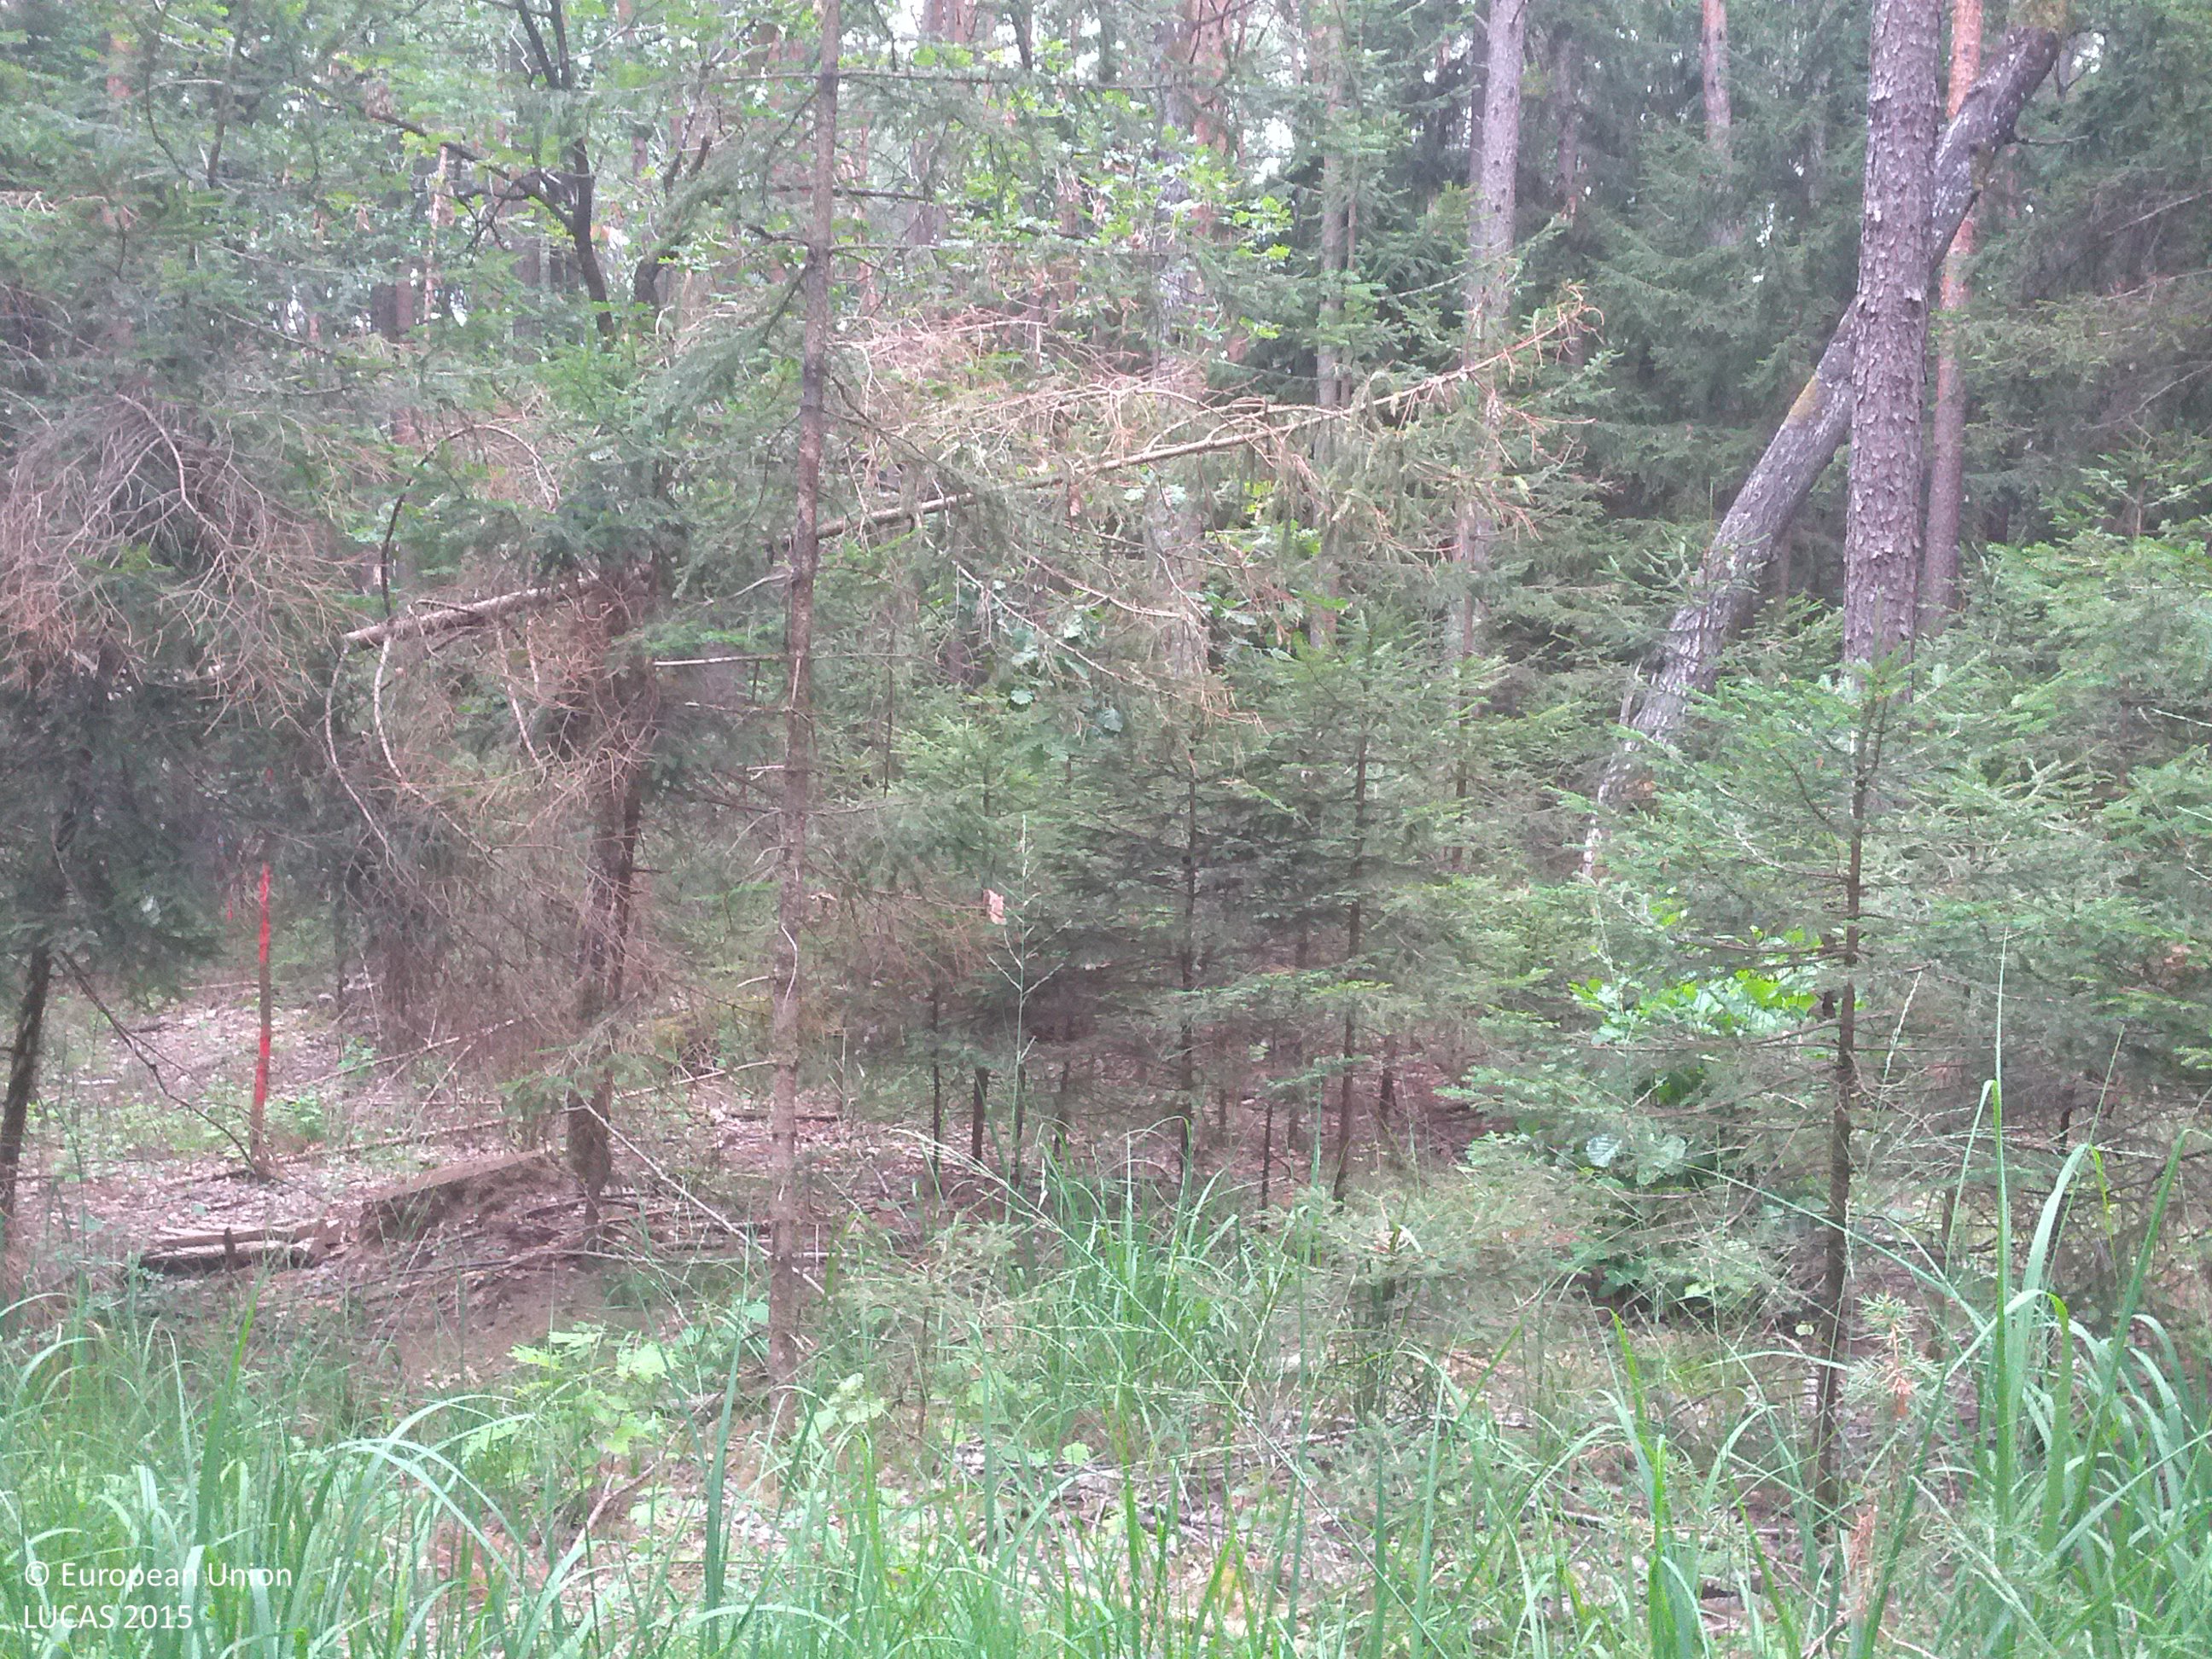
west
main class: Woodland
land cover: Pine dominated coniferous woodland
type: hemiboreal forest and nemoral coniferous forest and mixed broadleaved-coniferous forest
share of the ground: > 75 %
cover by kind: coniferous forest trees 80 %, herbaceous plants 15 %, unconsolidated bare surface 5 %
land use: Forestry
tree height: > 5 m
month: July
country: AT
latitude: 47.3475
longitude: 16.1575
